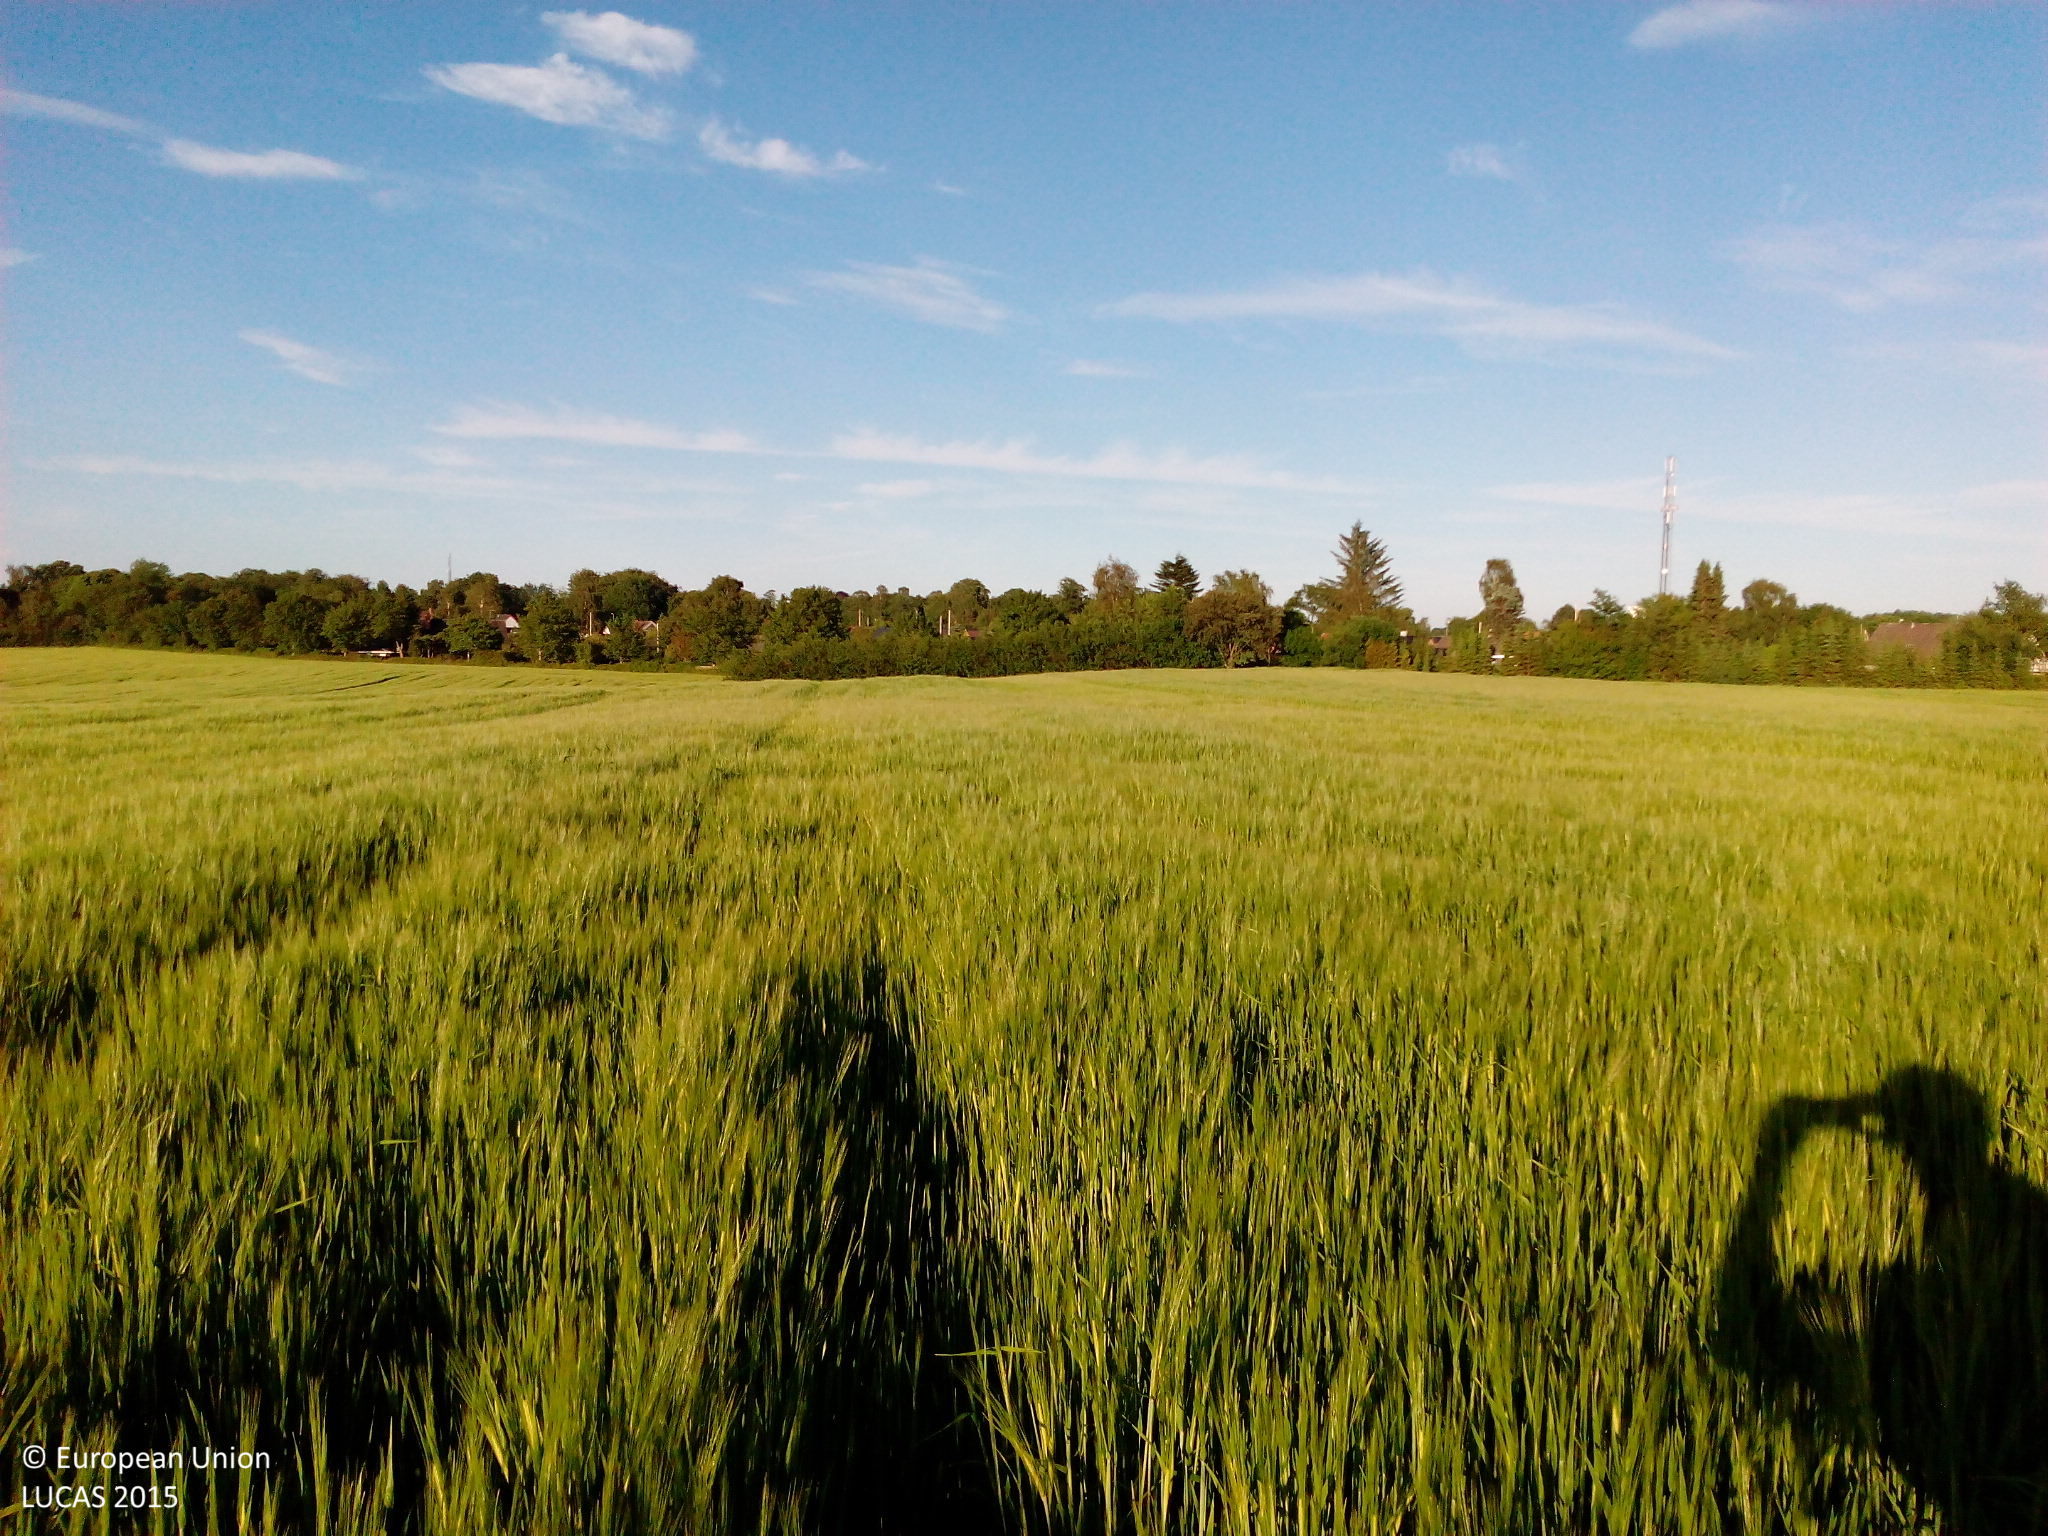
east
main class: Cropland
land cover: Triticale
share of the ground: > 75 %
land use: Agriculture (excluding fallow land and kitchen gardens)
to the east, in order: Triticale; Broadleaved woodland; Artificial constructions in urban areas
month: June
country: DK
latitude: 56.3473
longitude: 10.7595
